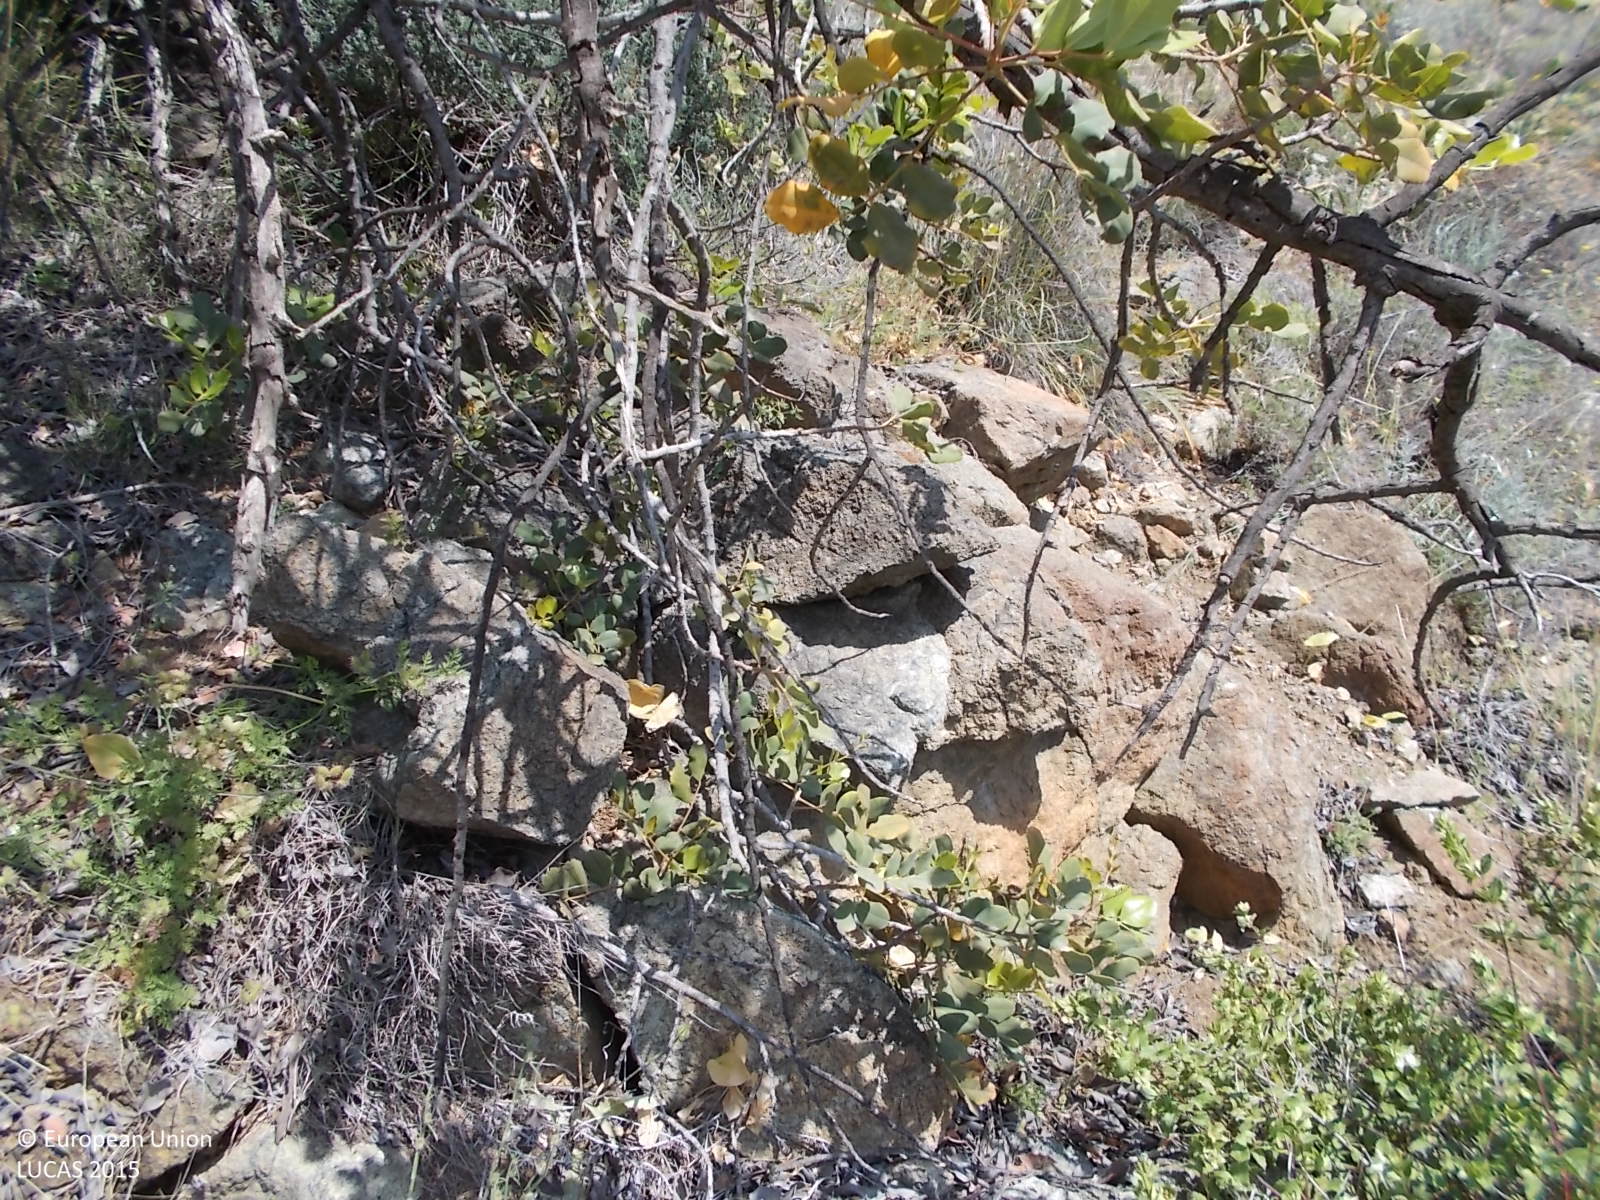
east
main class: Shrubland
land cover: Shrubland with sparse tree cover
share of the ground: > 75 %
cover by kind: shrubs 95 %, broadleaved forest trees 5 %
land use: Semi-natural and natural areas not in use
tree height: > 5 m
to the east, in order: Shrubland with sparse tree cover; Shrubland without tree cover; Shrubland with sparse tree cover; Rivers and streams; Shrubland without tree cover; Shrubland with sparse tree cover
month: April
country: CY
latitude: 34.7674
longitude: 33.1036
